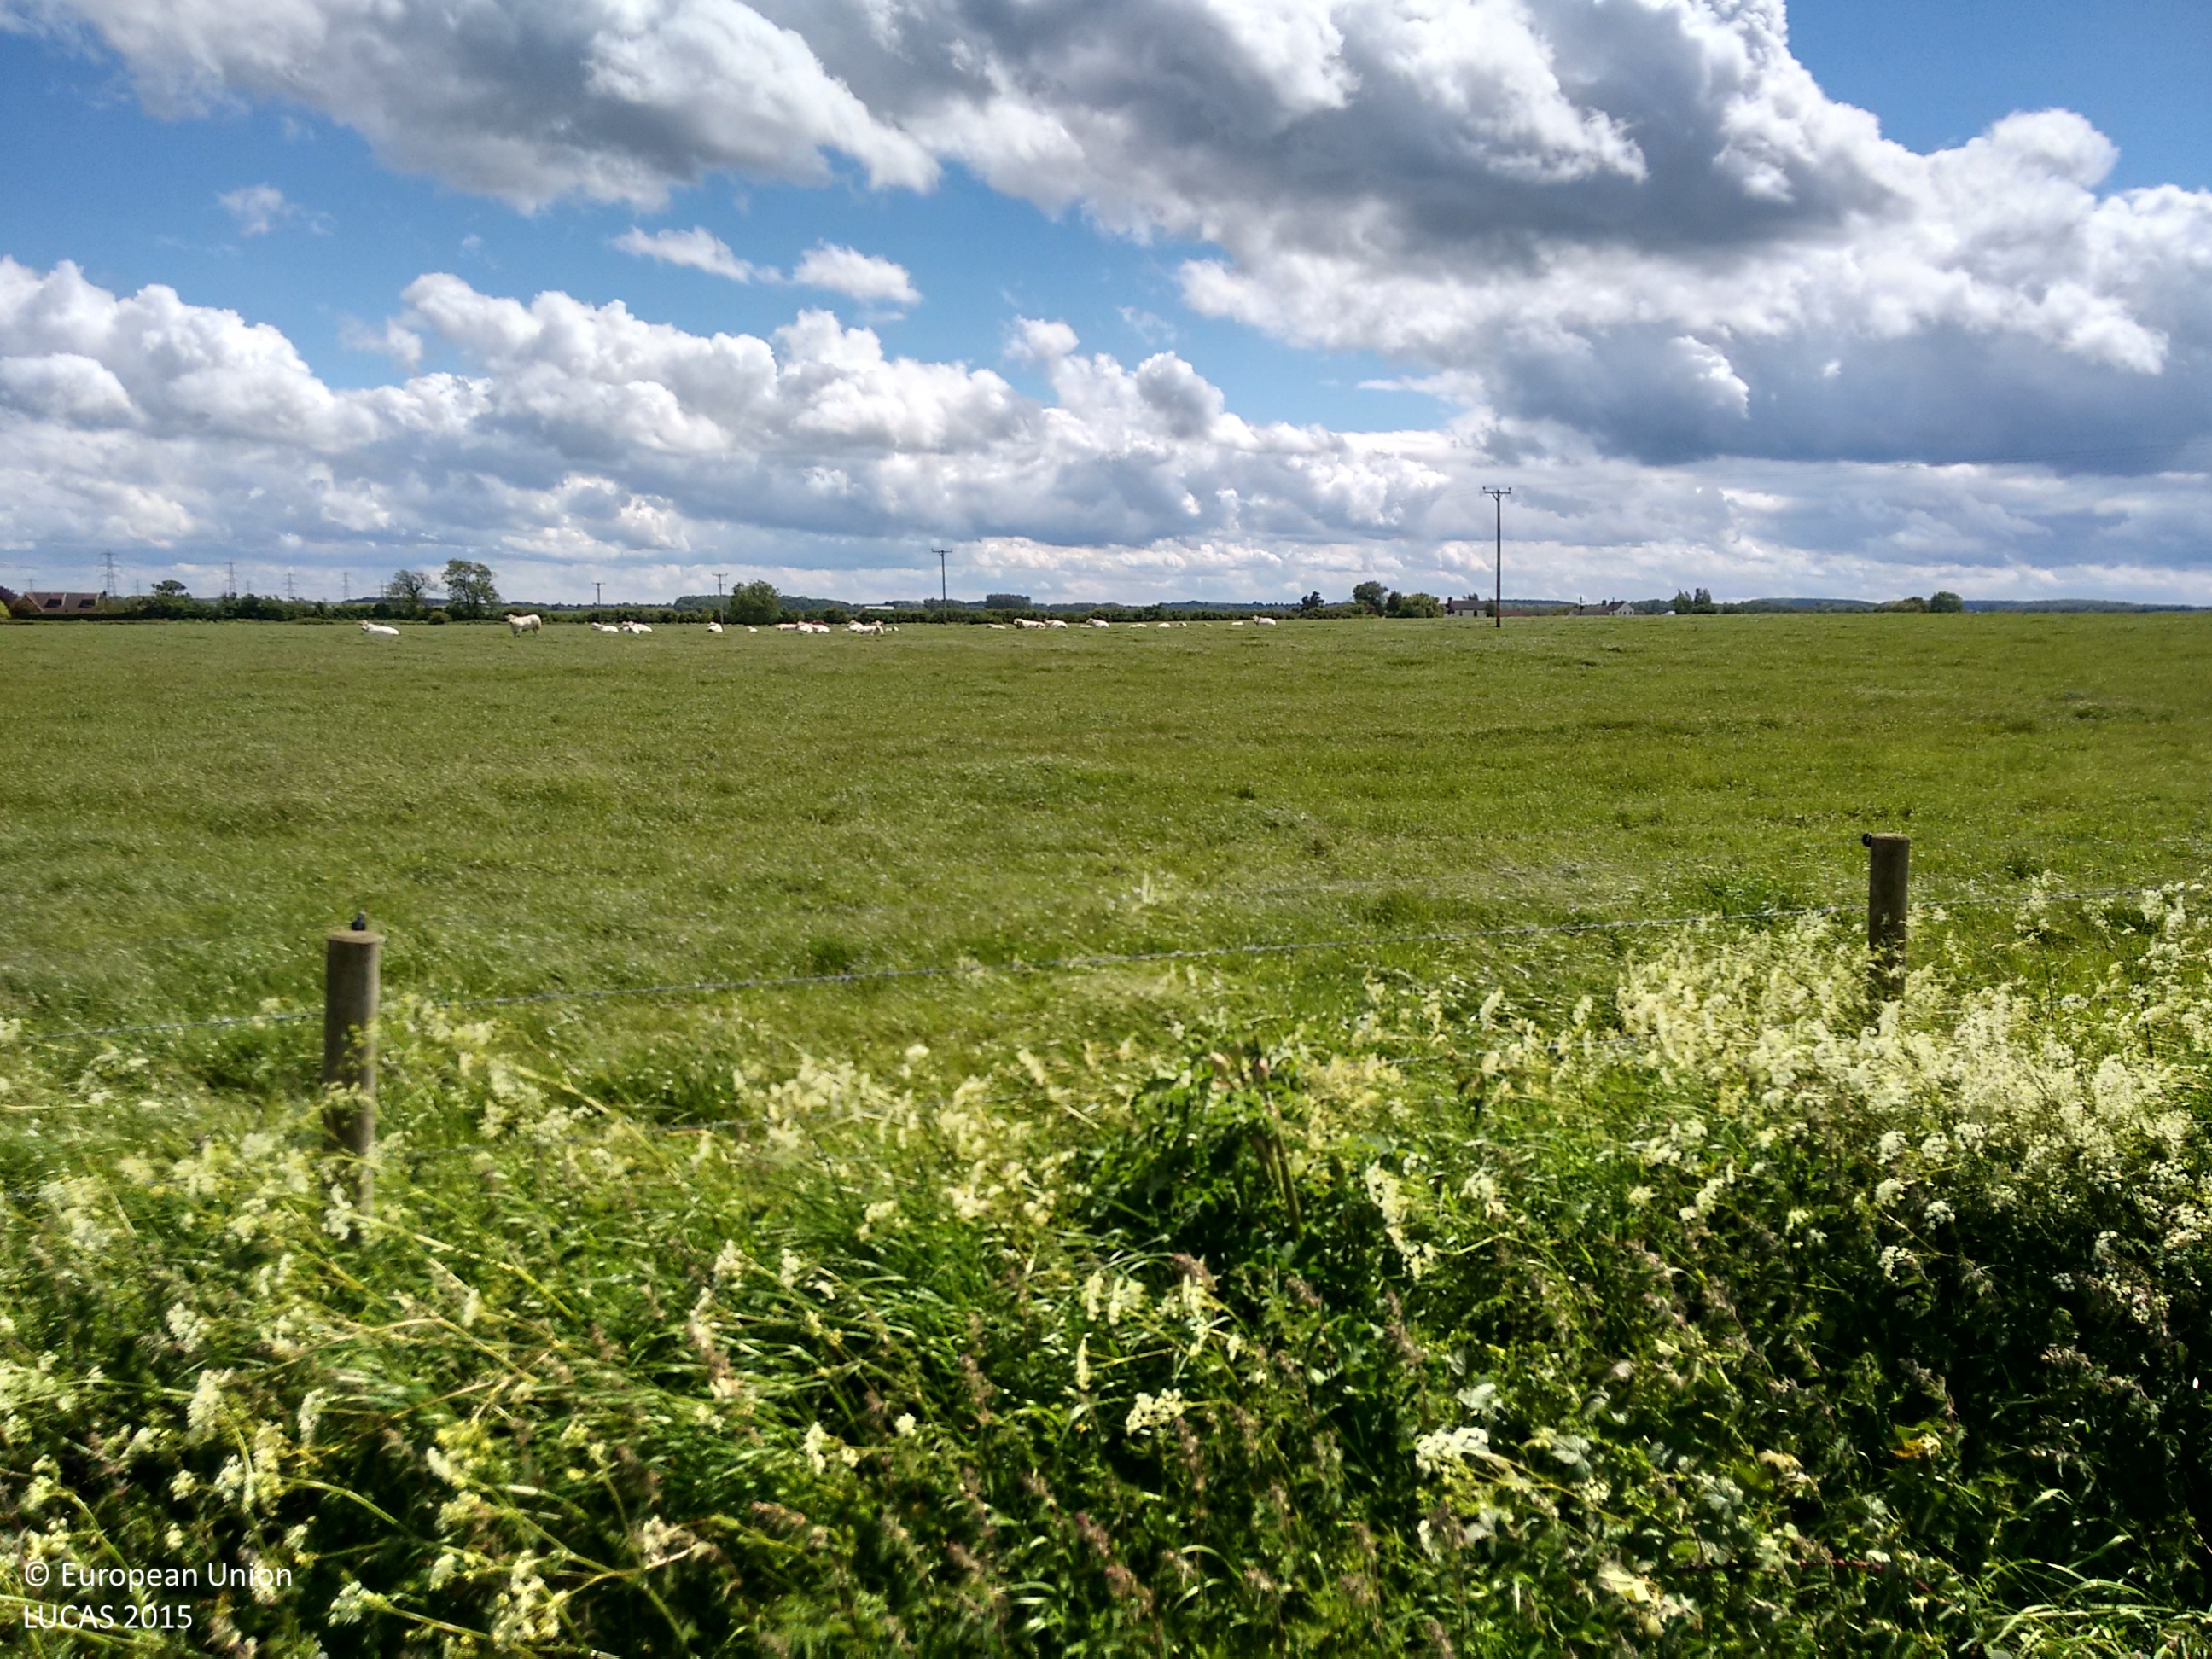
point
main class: Grassland
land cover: Grassland without tree/shrub cover
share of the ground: > 75 %
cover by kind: herbaceous plants 100 %
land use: Agriculture (excluding fallow land and kitchen gardens)
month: June
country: GB
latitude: 53.5839
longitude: -0.2302
